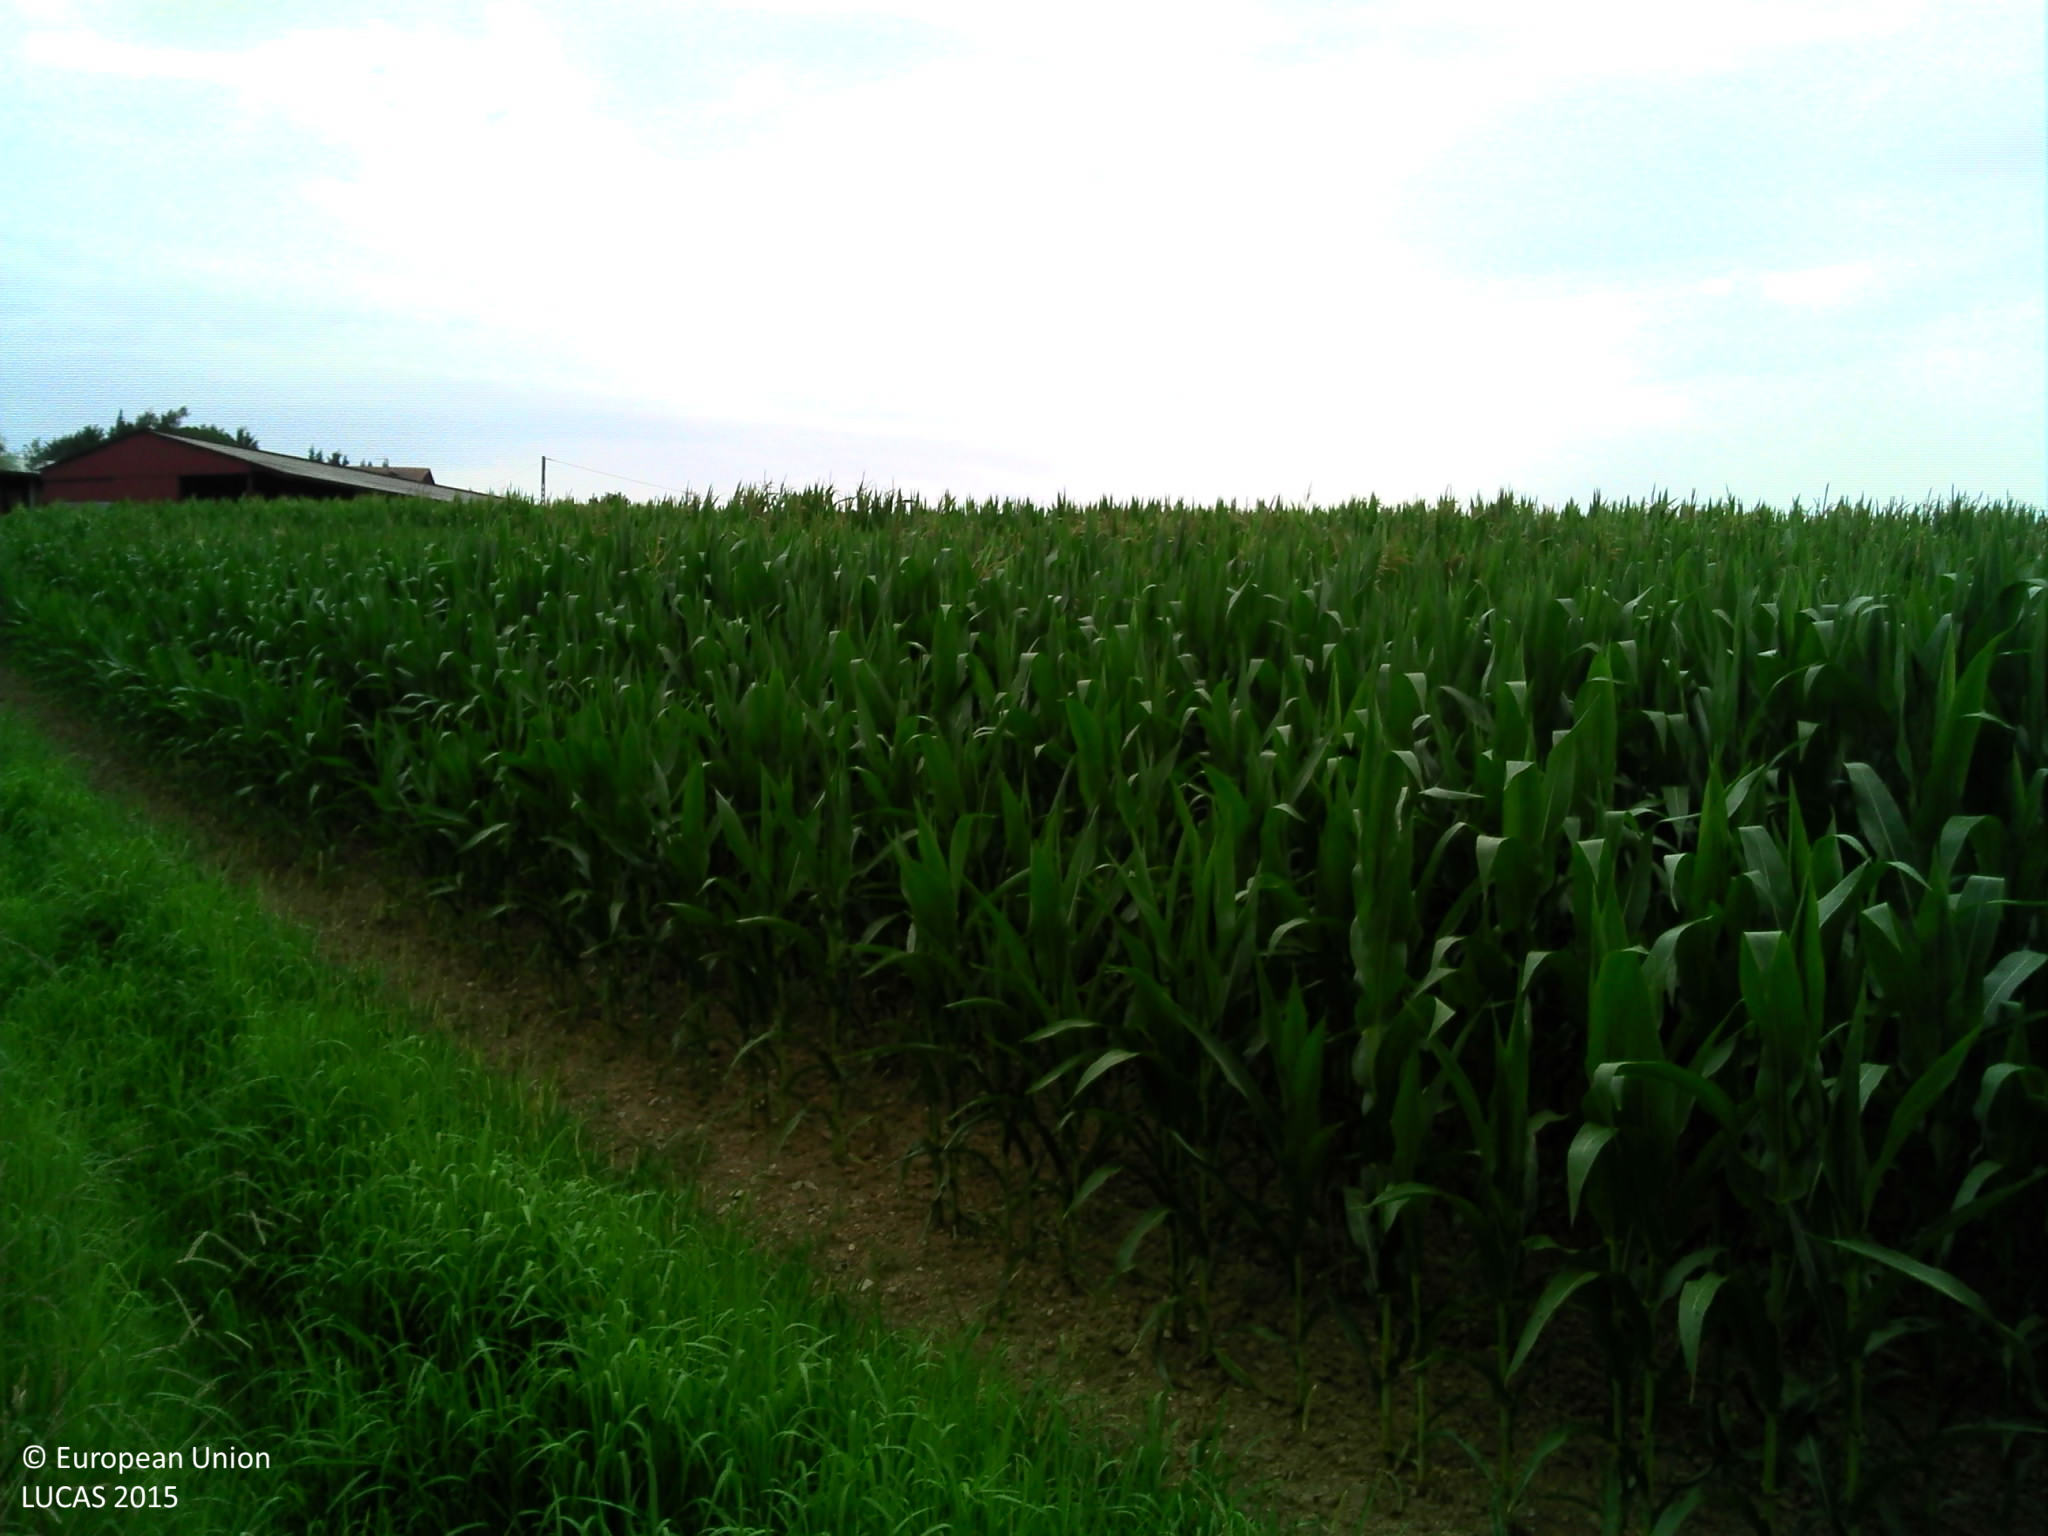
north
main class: Cropland
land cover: Maize
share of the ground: > 75 %
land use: Agriculture (excluding fallow land and kitchen gardens)
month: August
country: FR
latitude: 43.4253
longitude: -1.2686
